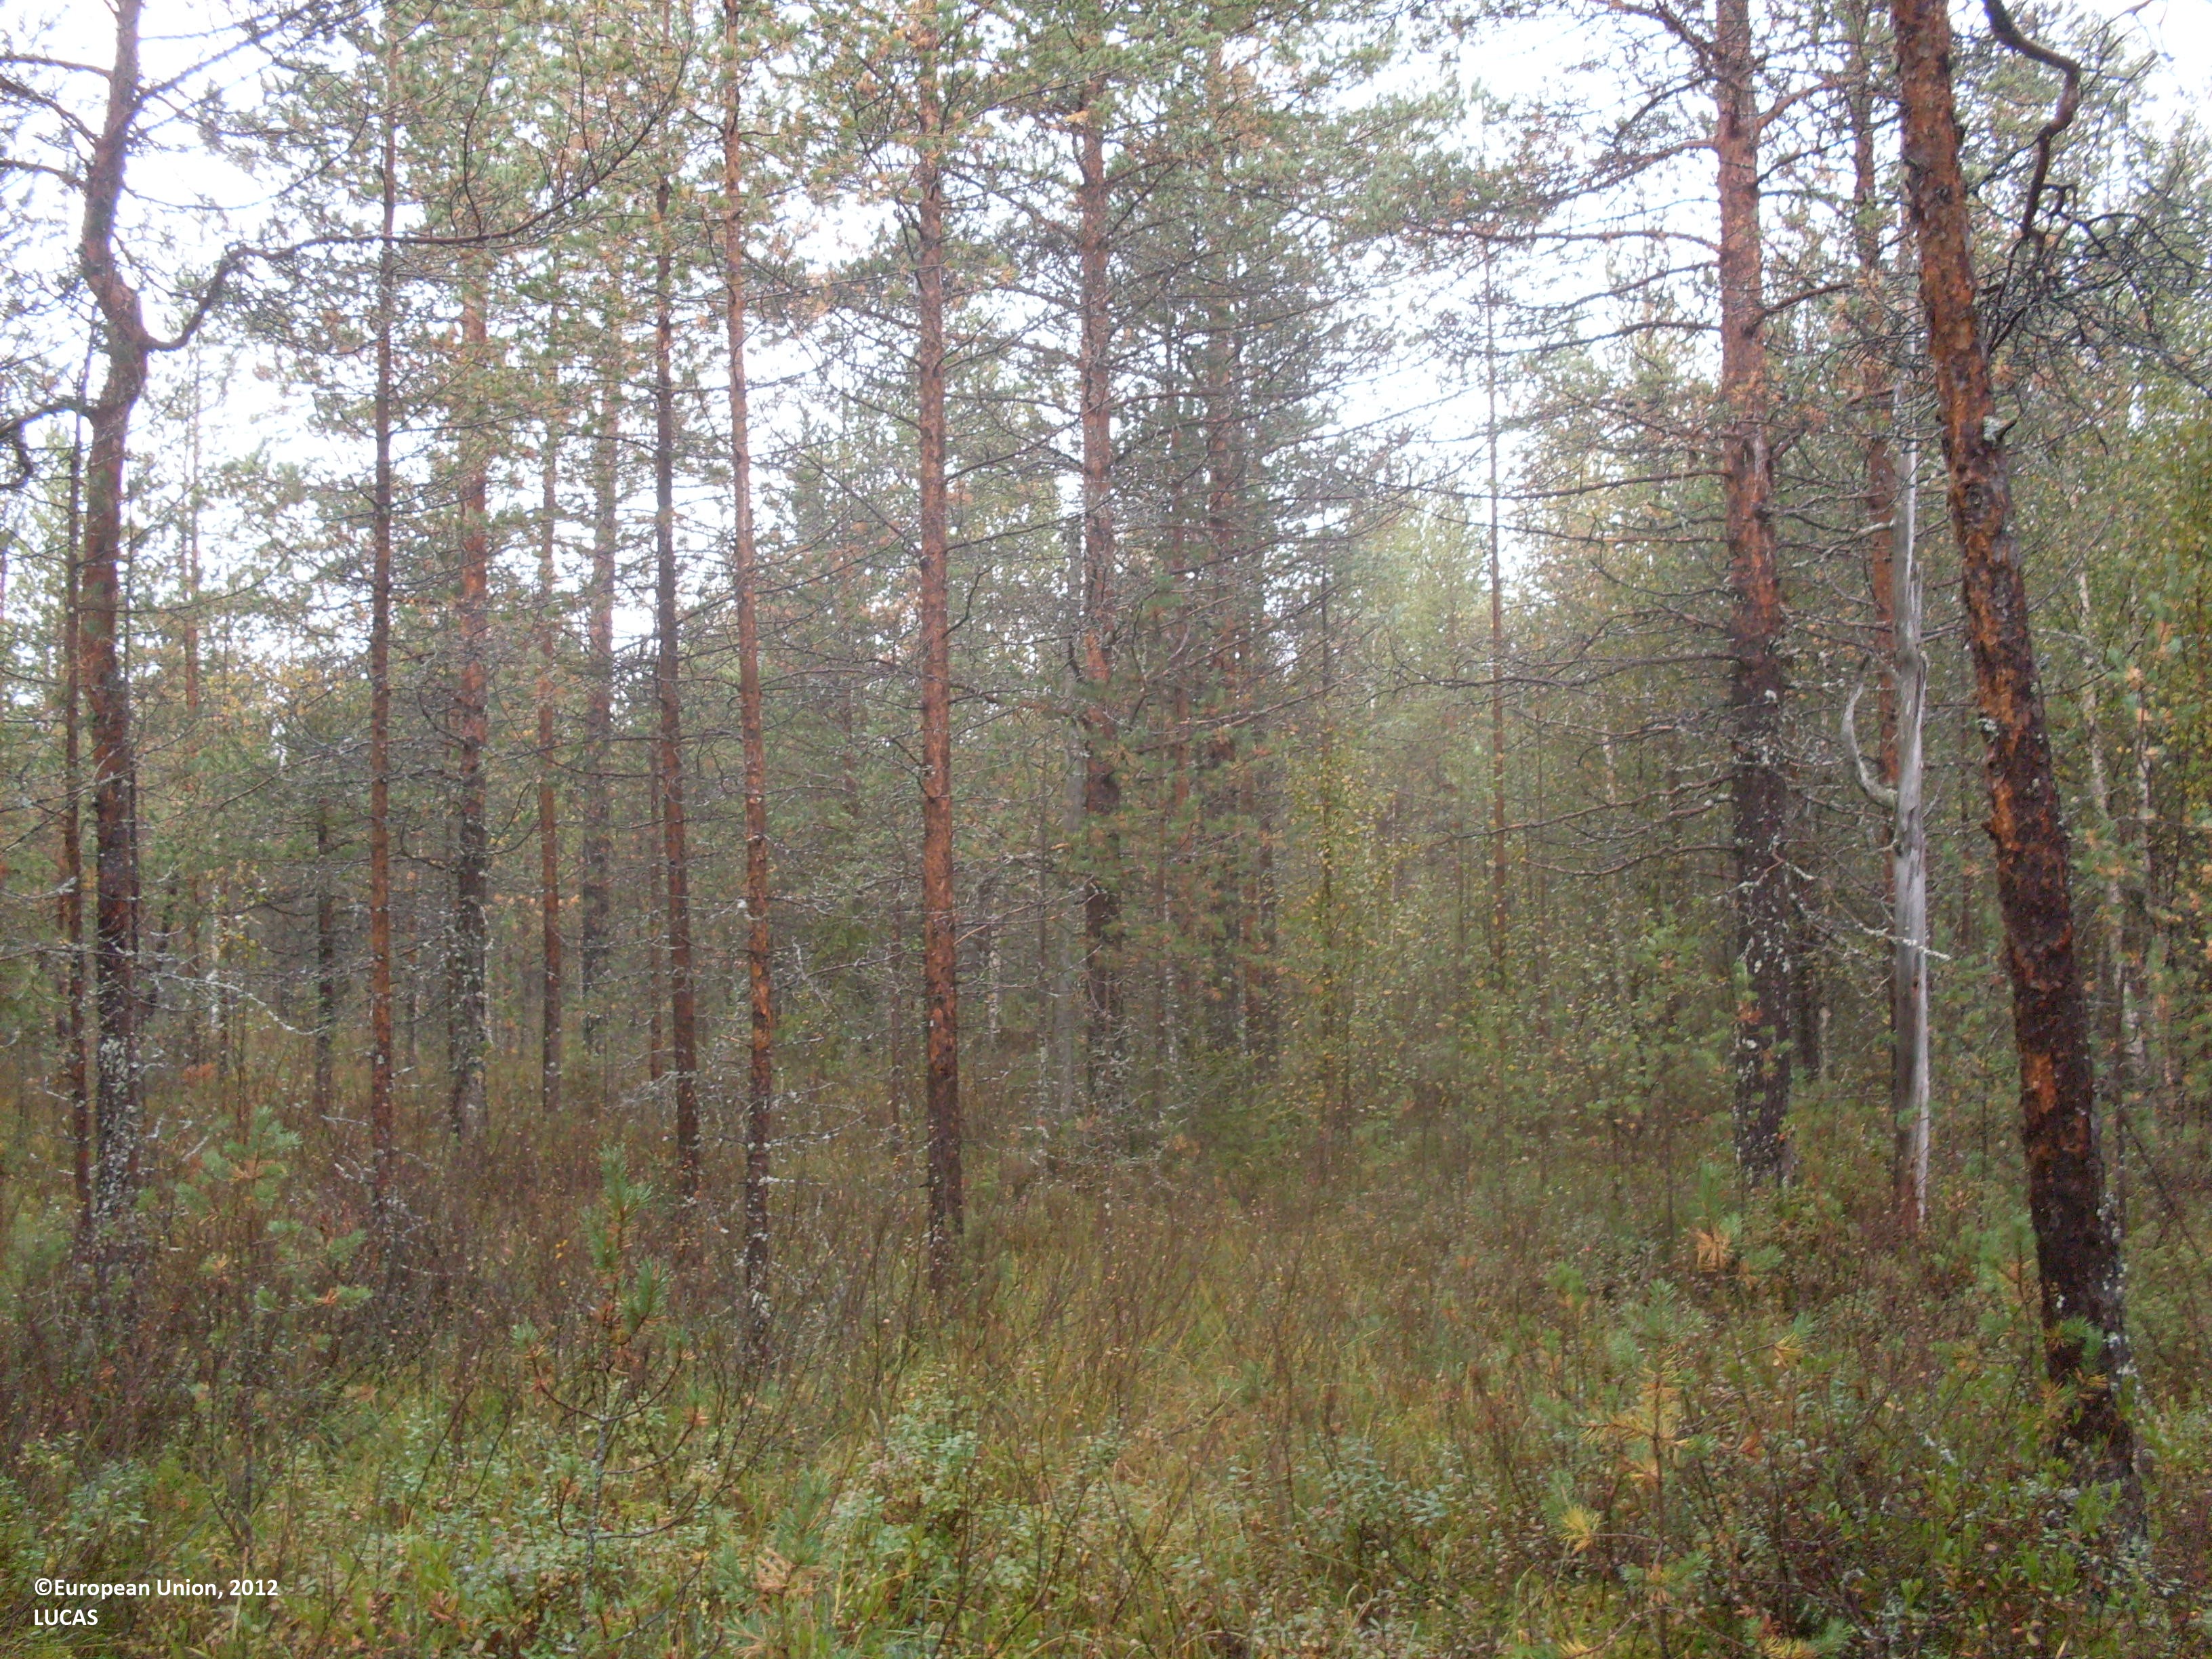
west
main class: Woodland
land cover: Pine dominated coniferous woodland
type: boreal forest
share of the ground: 50 - 75 %
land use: Forestry
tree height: > 5 m
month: September
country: FI
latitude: 64.1964
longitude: 29.8119
